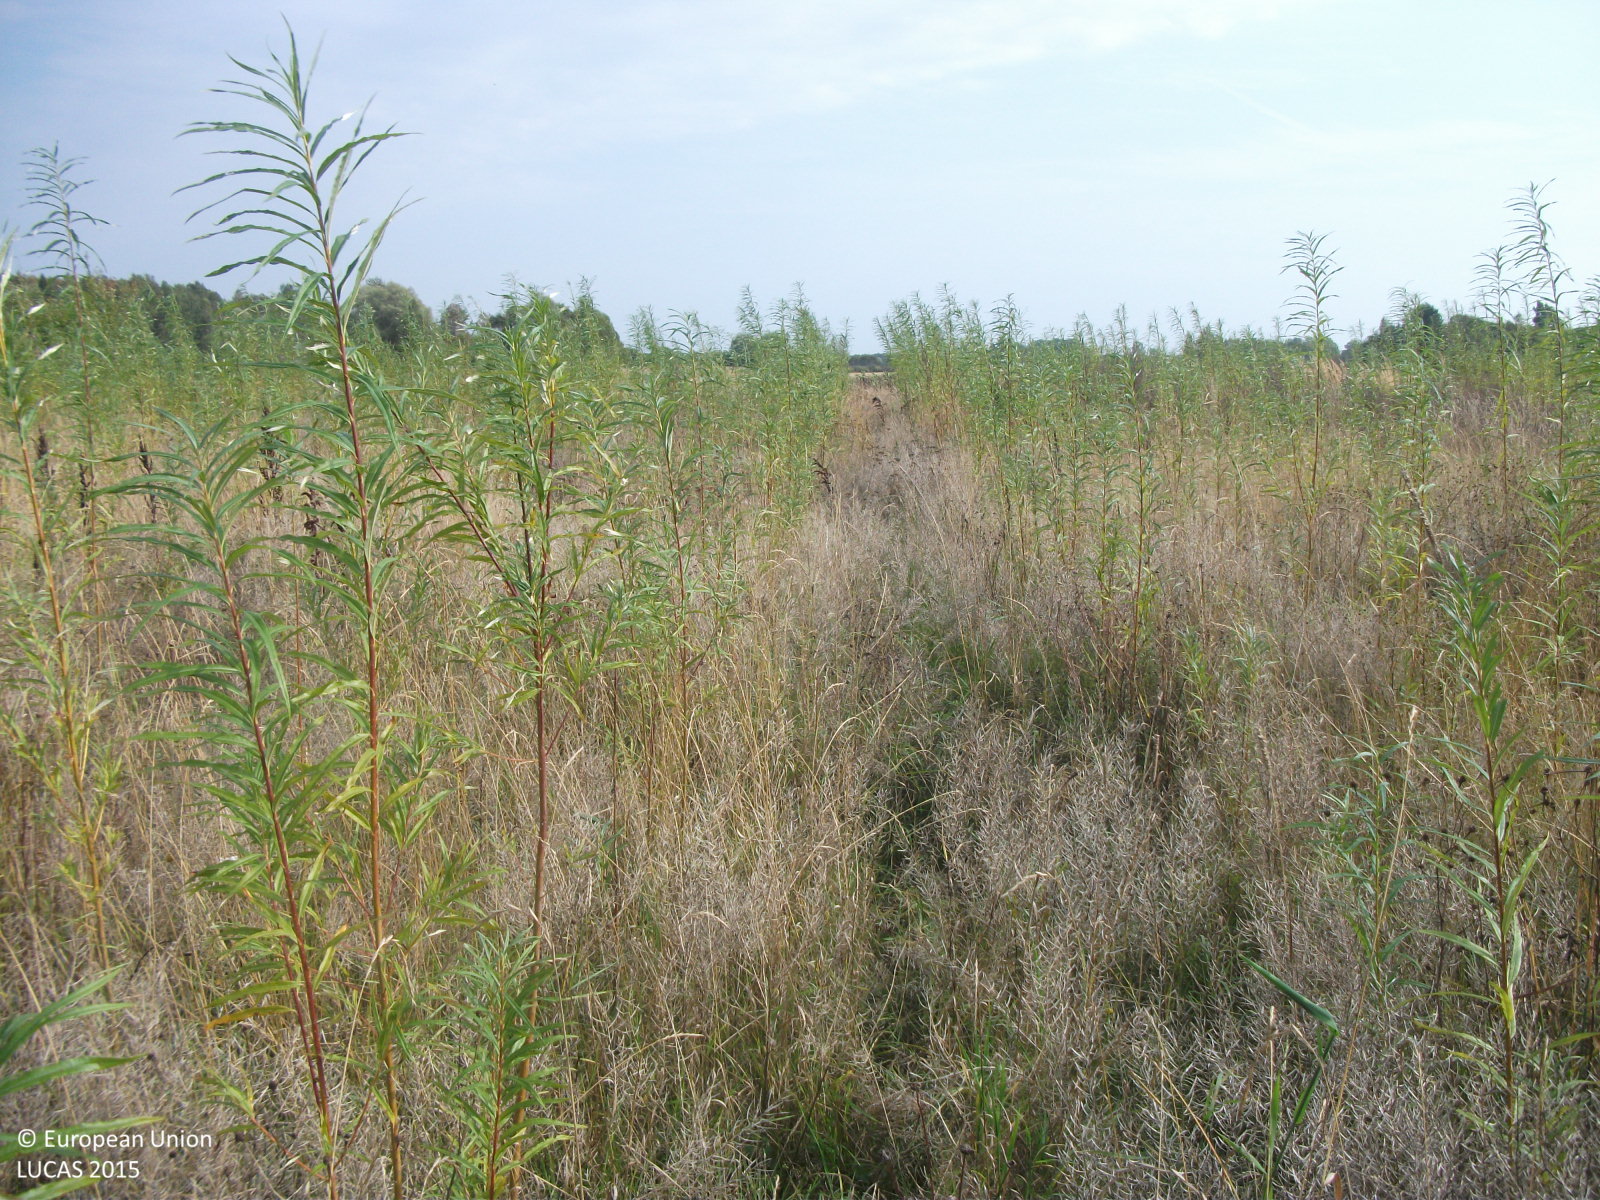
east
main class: Cropland
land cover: Permanent industrial crops
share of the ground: 25 - 50 %
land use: Agriculture (excluding fallow land and kitchen gardens)
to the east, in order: Permanent industrial crops; Tracks; Grass margins; Dry pulses
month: September
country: LV
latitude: 57.7754
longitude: 24.4991
